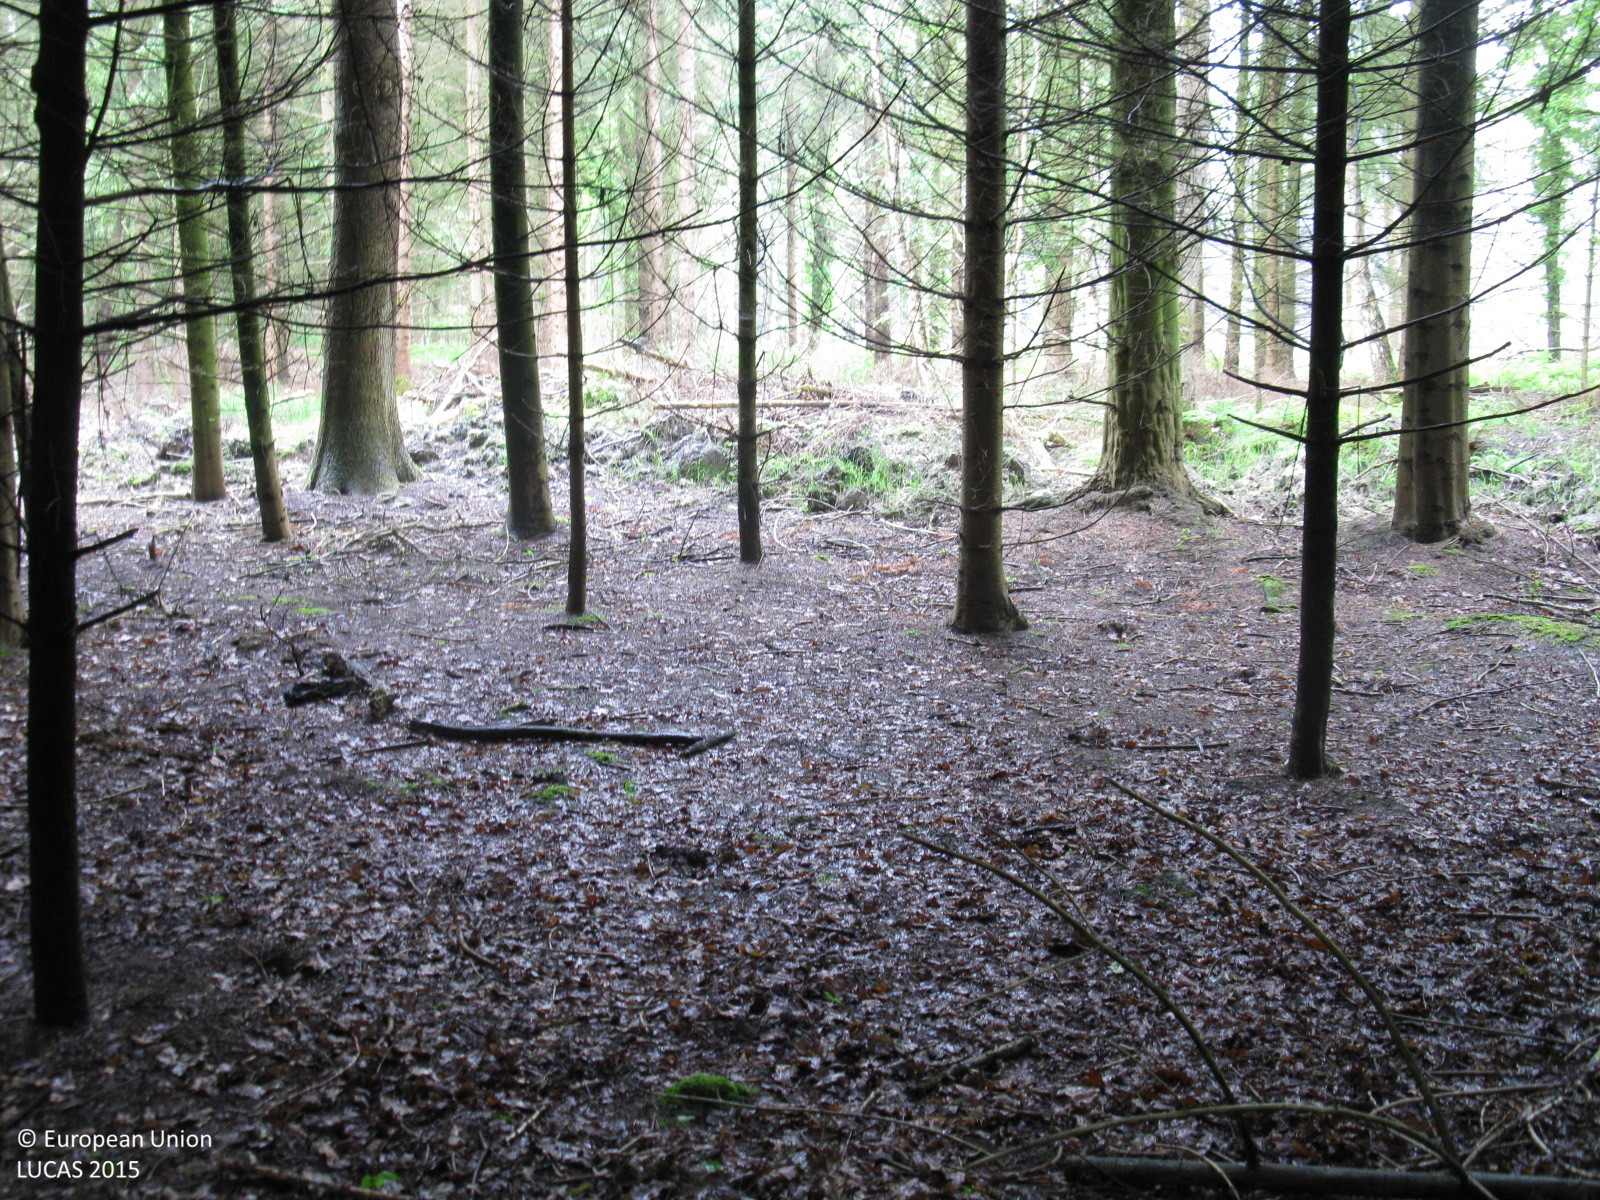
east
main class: Woodland
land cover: Spruce dominated mixed woodland
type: hemiboreal forest and nemoral coniferous forest and mixed broadleaved-coniferous forest
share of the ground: > 75 %
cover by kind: coniferous forest trees 70 %, broadleaved forest trees 30 %
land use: Forestry
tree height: > 5 m
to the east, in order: Spruce dominated mixed woodland; Ditches and canals; Spruce dominated coniferous woodland; Ditches and canals; Spruce dominated coniferous woodland
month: June
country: DE
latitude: 53.6228
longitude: 7.2641
